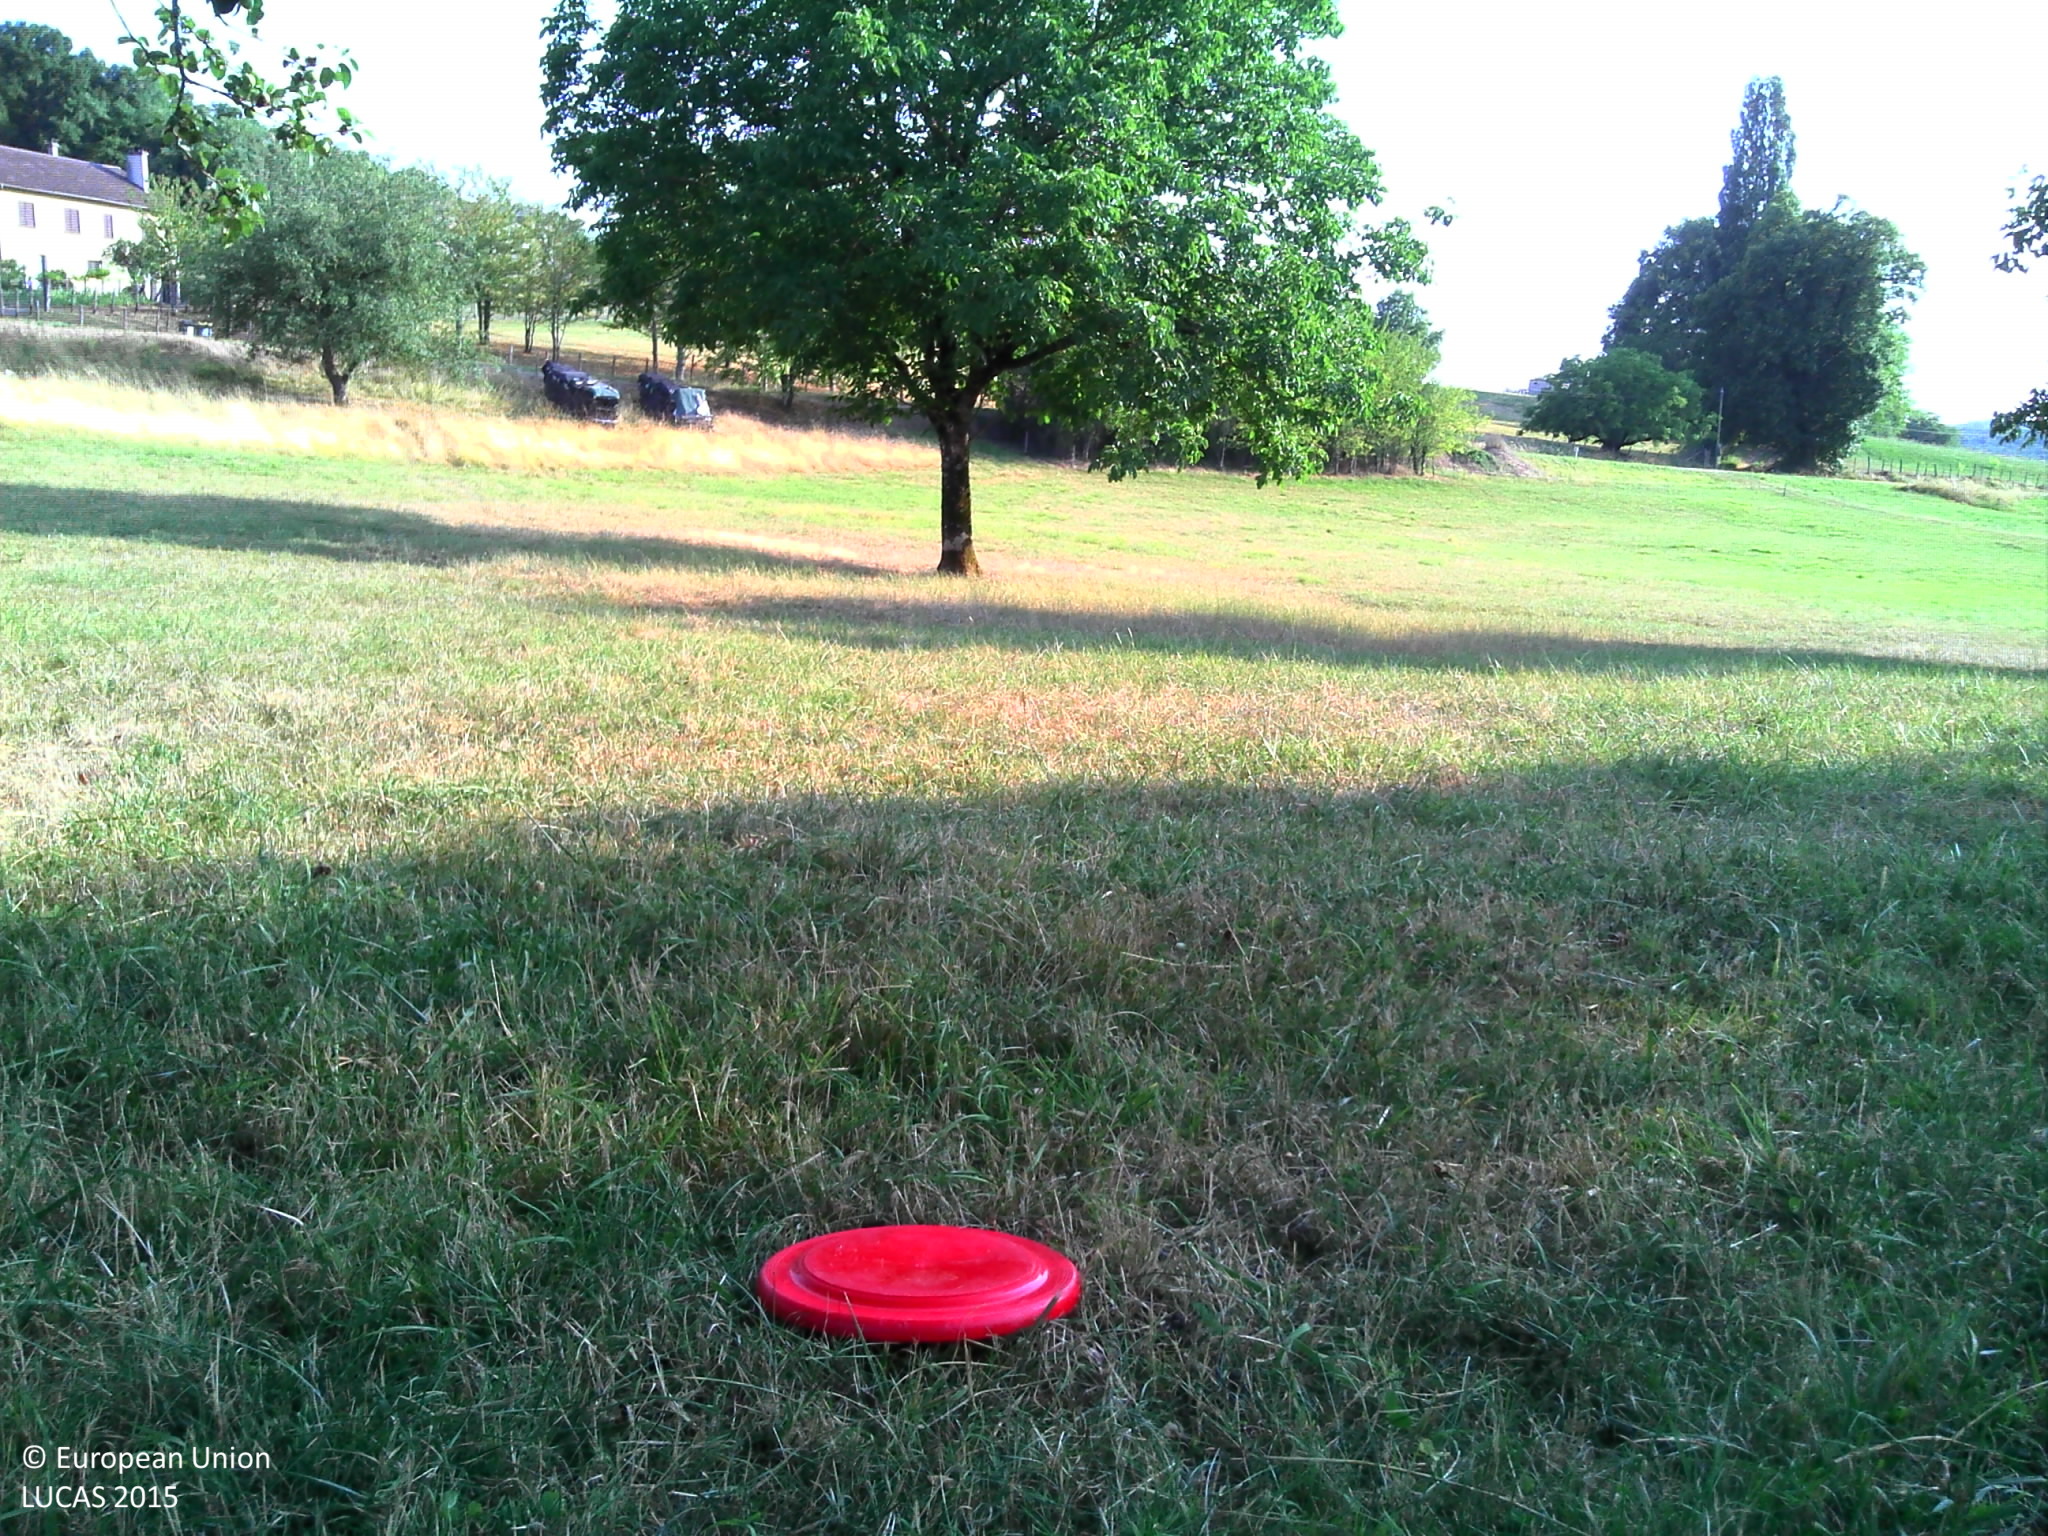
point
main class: Cropland
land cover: Apple fruit
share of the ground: 25 - 50 %
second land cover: Grassland without tree/shrub cover
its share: 50 - 75 %
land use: Agriculture (excluding fallow land and kitchen gardens)
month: July
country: FR
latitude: 45.3272
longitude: 1.0992
